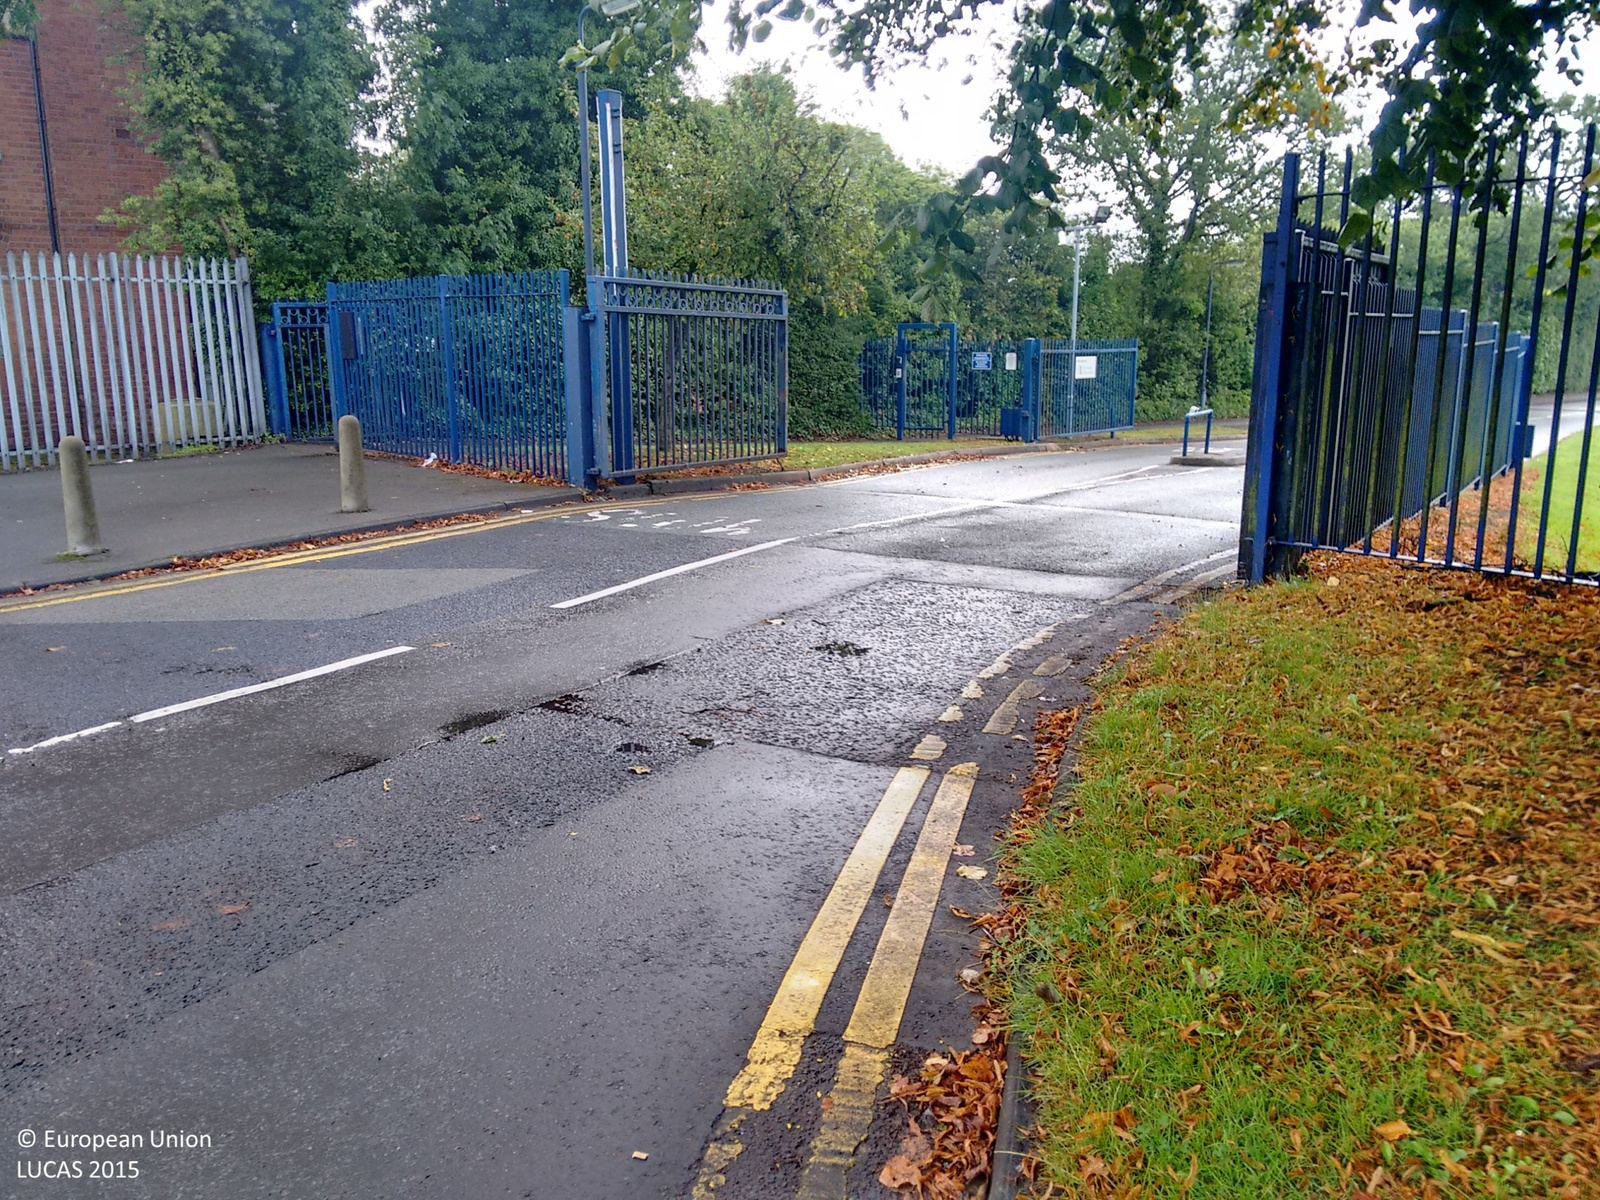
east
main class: Grassland
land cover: Grassland with sparse tree/shrub cover
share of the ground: > 75 %
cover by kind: herbaceous plants 65 %, consolidated bare surface 30 %, broadleaved forest trees 5 %
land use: Amenities, museums, leisure
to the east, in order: Grassland with sparse tree/shrub cover; Artificial constructions in urban areas
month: September
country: GB
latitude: 52.4047
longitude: -1.9789
